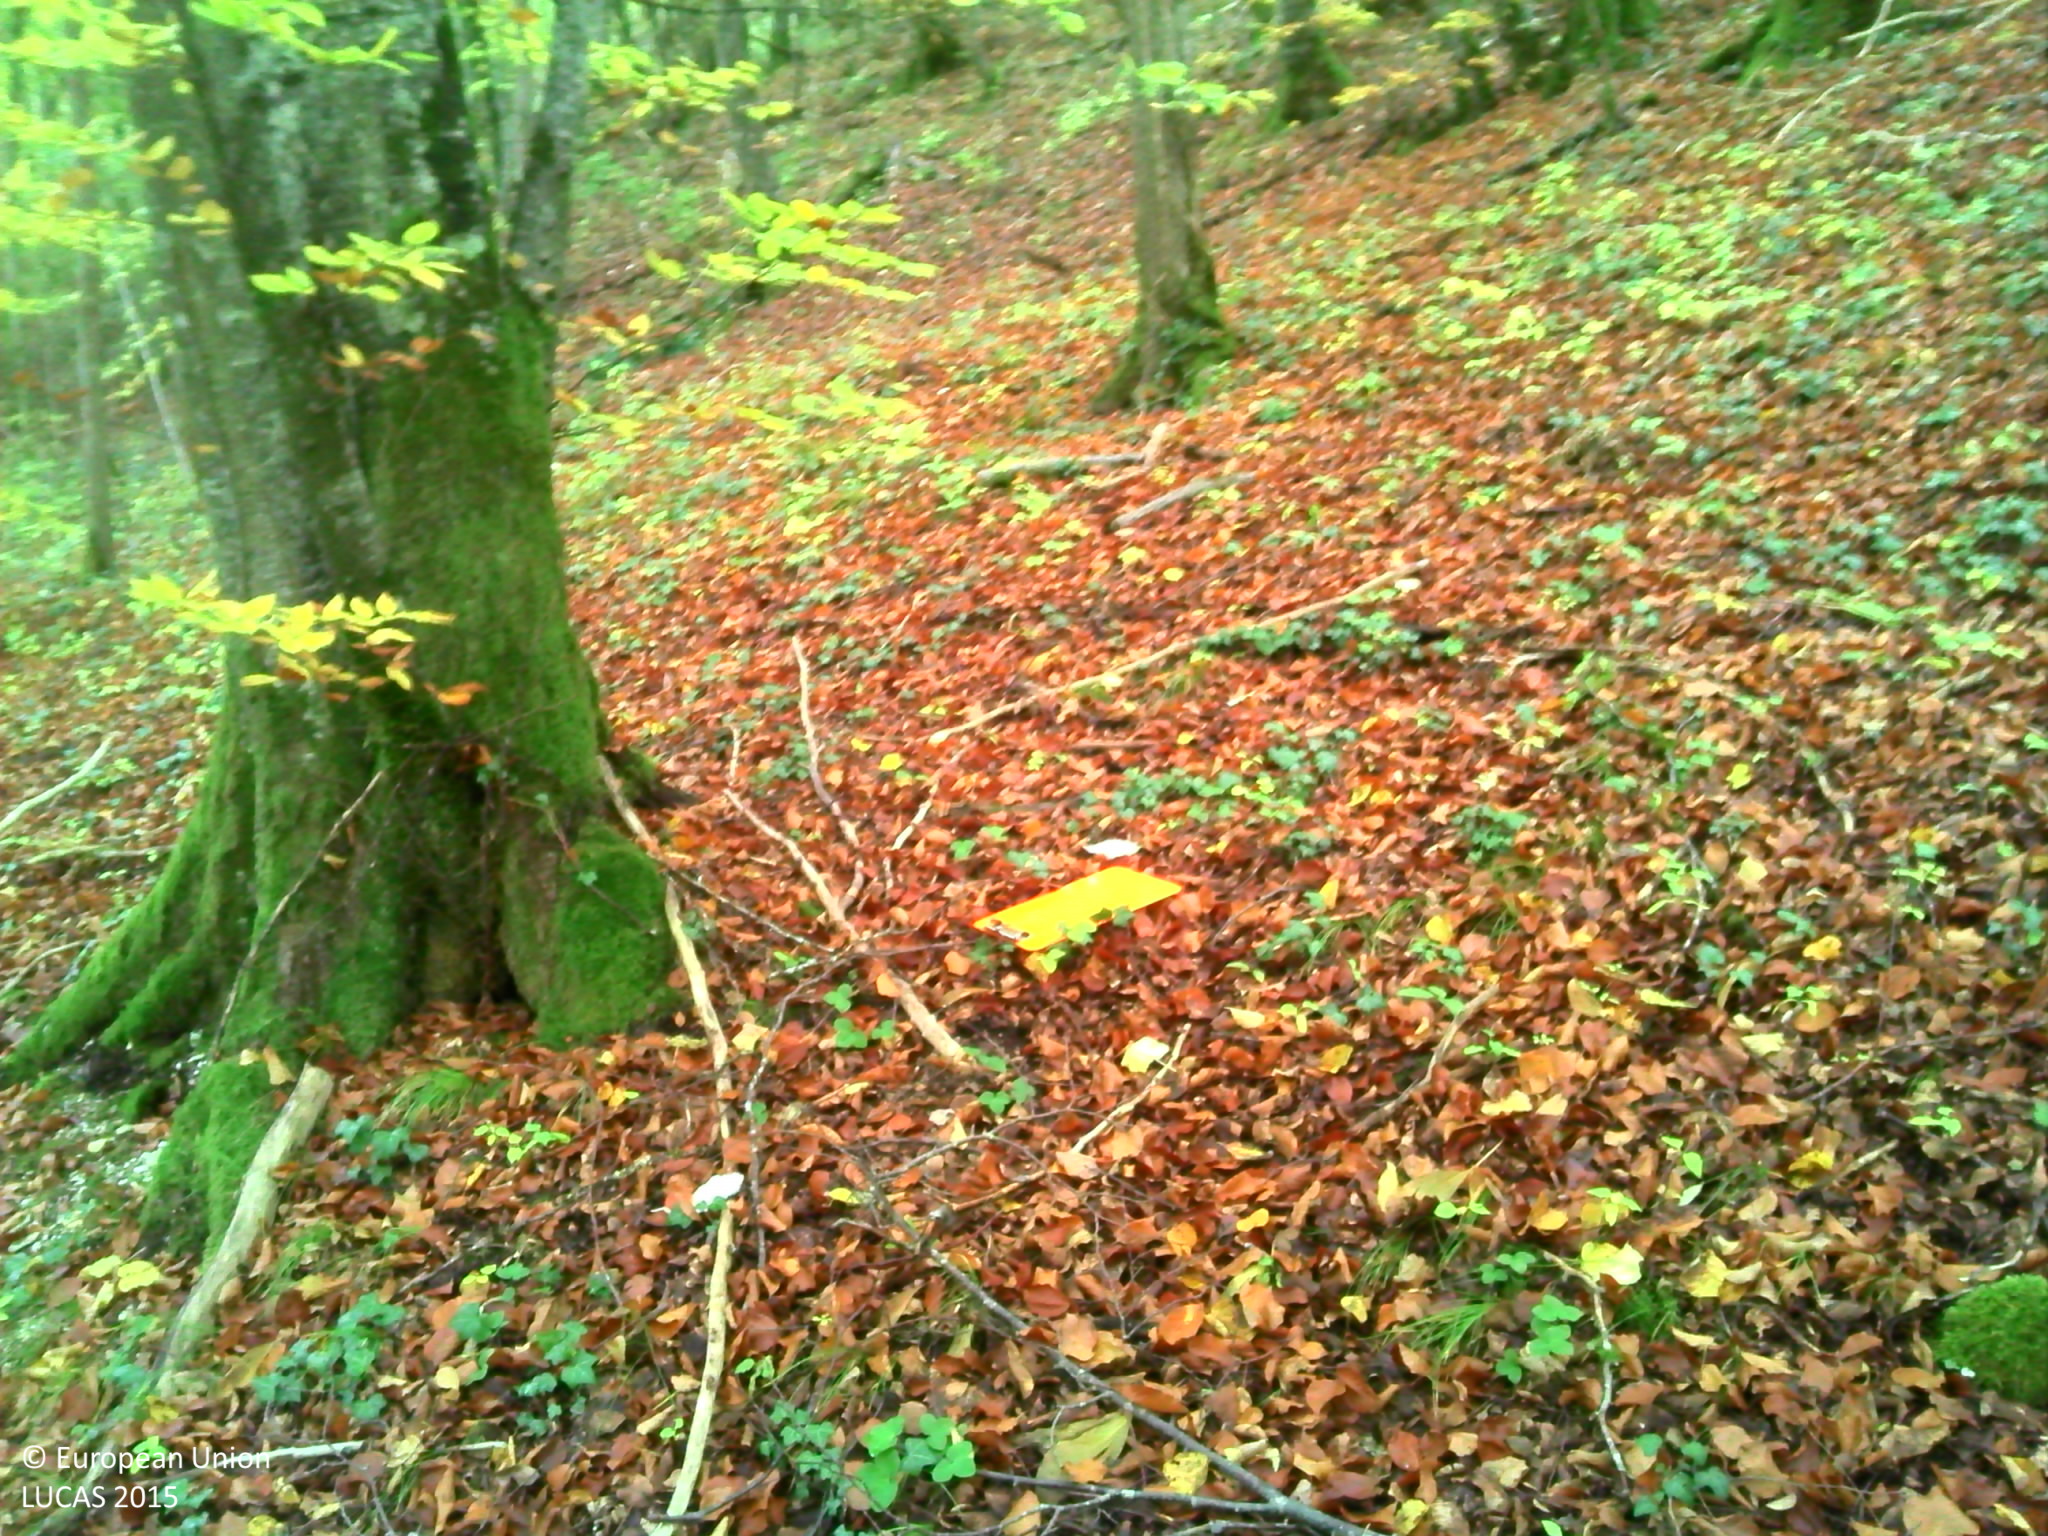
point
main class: Woodland
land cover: Broadleaved woodland
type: beech forest
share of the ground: > 75 %
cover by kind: broadleaved forest trees 100 %
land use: Forestry
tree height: > 5 m
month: October
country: FR
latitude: 47.4238
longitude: 4.9761
